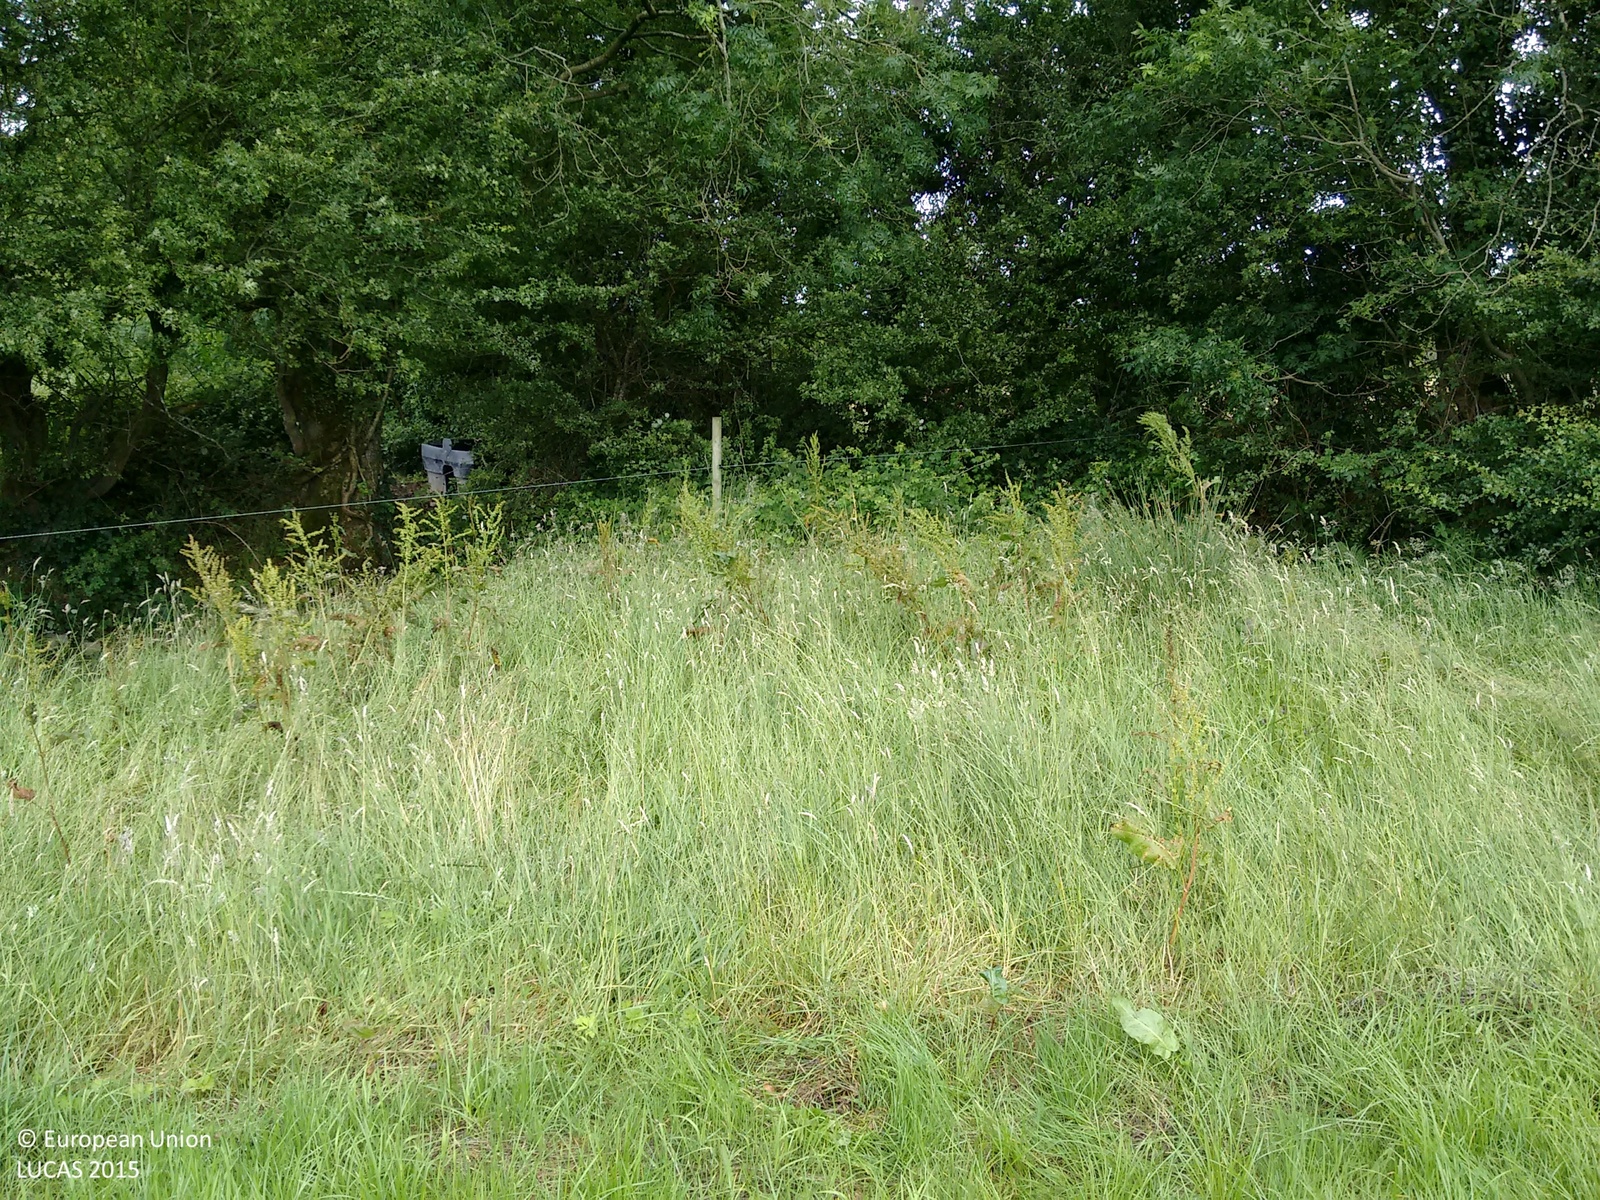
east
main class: Grassland
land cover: Grassland without tree/shrub cover
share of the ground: > 75 %
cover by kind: herbaceous plants 95 %, shrubs 5 %
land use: Agriculture (excluding fallow land and kitchen gardens)
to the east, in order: Grassland without tree/shrub cover; Fences; Ditches and canals; Broadleaved woodland; Grassland without tree/shrub cover; Electric lines; Grassland without tree/shrub cover; Ditches and canals; Managed hedges; Grassland without tree/shrub cover; Electric lines; Ditches and canals; Managed hedges; Grassland without tree/shrub cover
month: July
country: IE
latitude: 53.6544
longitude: -7.6694
